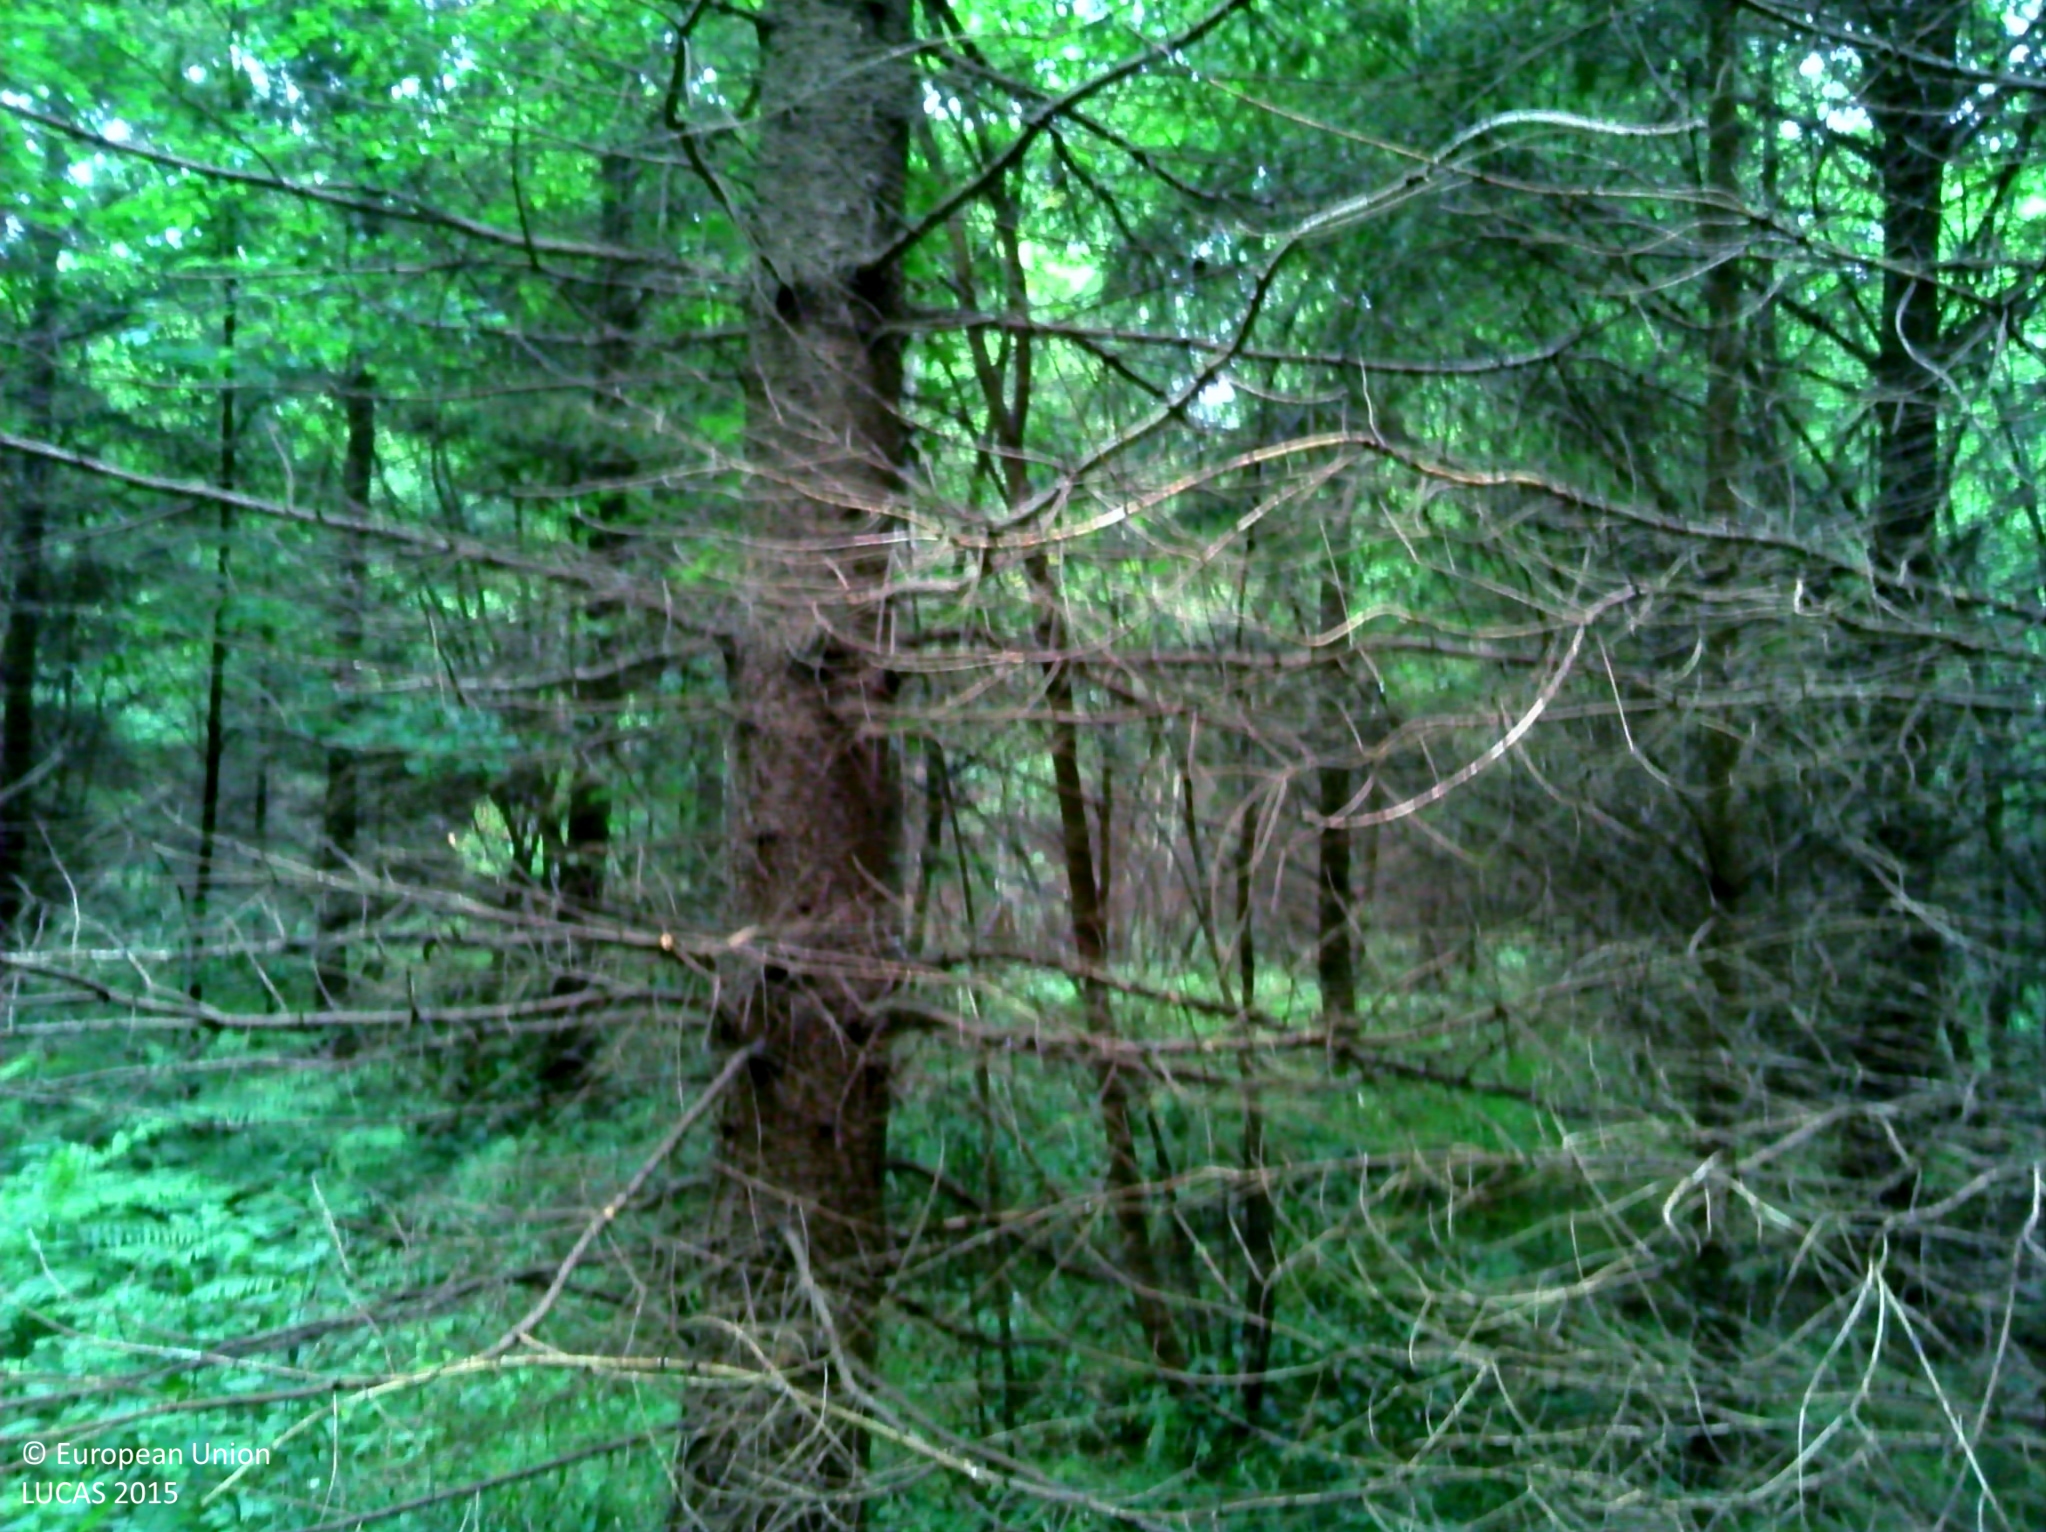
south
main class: Woodland
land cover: Spruce dominated mixed woodland
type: hemiboreal forest and nemoral coniferous forest and mixed broadleaved-coniferous forest
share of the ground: > 75 %
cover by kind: coniferous forest trees 55 %, broadleaved forest trees 30 %, shrubs 5 %, herbaceous plants 5 %, lichens and mosses 5 %
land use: Forestry
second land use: Sport
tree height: > 5 m
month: June
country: FR
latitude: 49.3813
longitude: 2.8409
